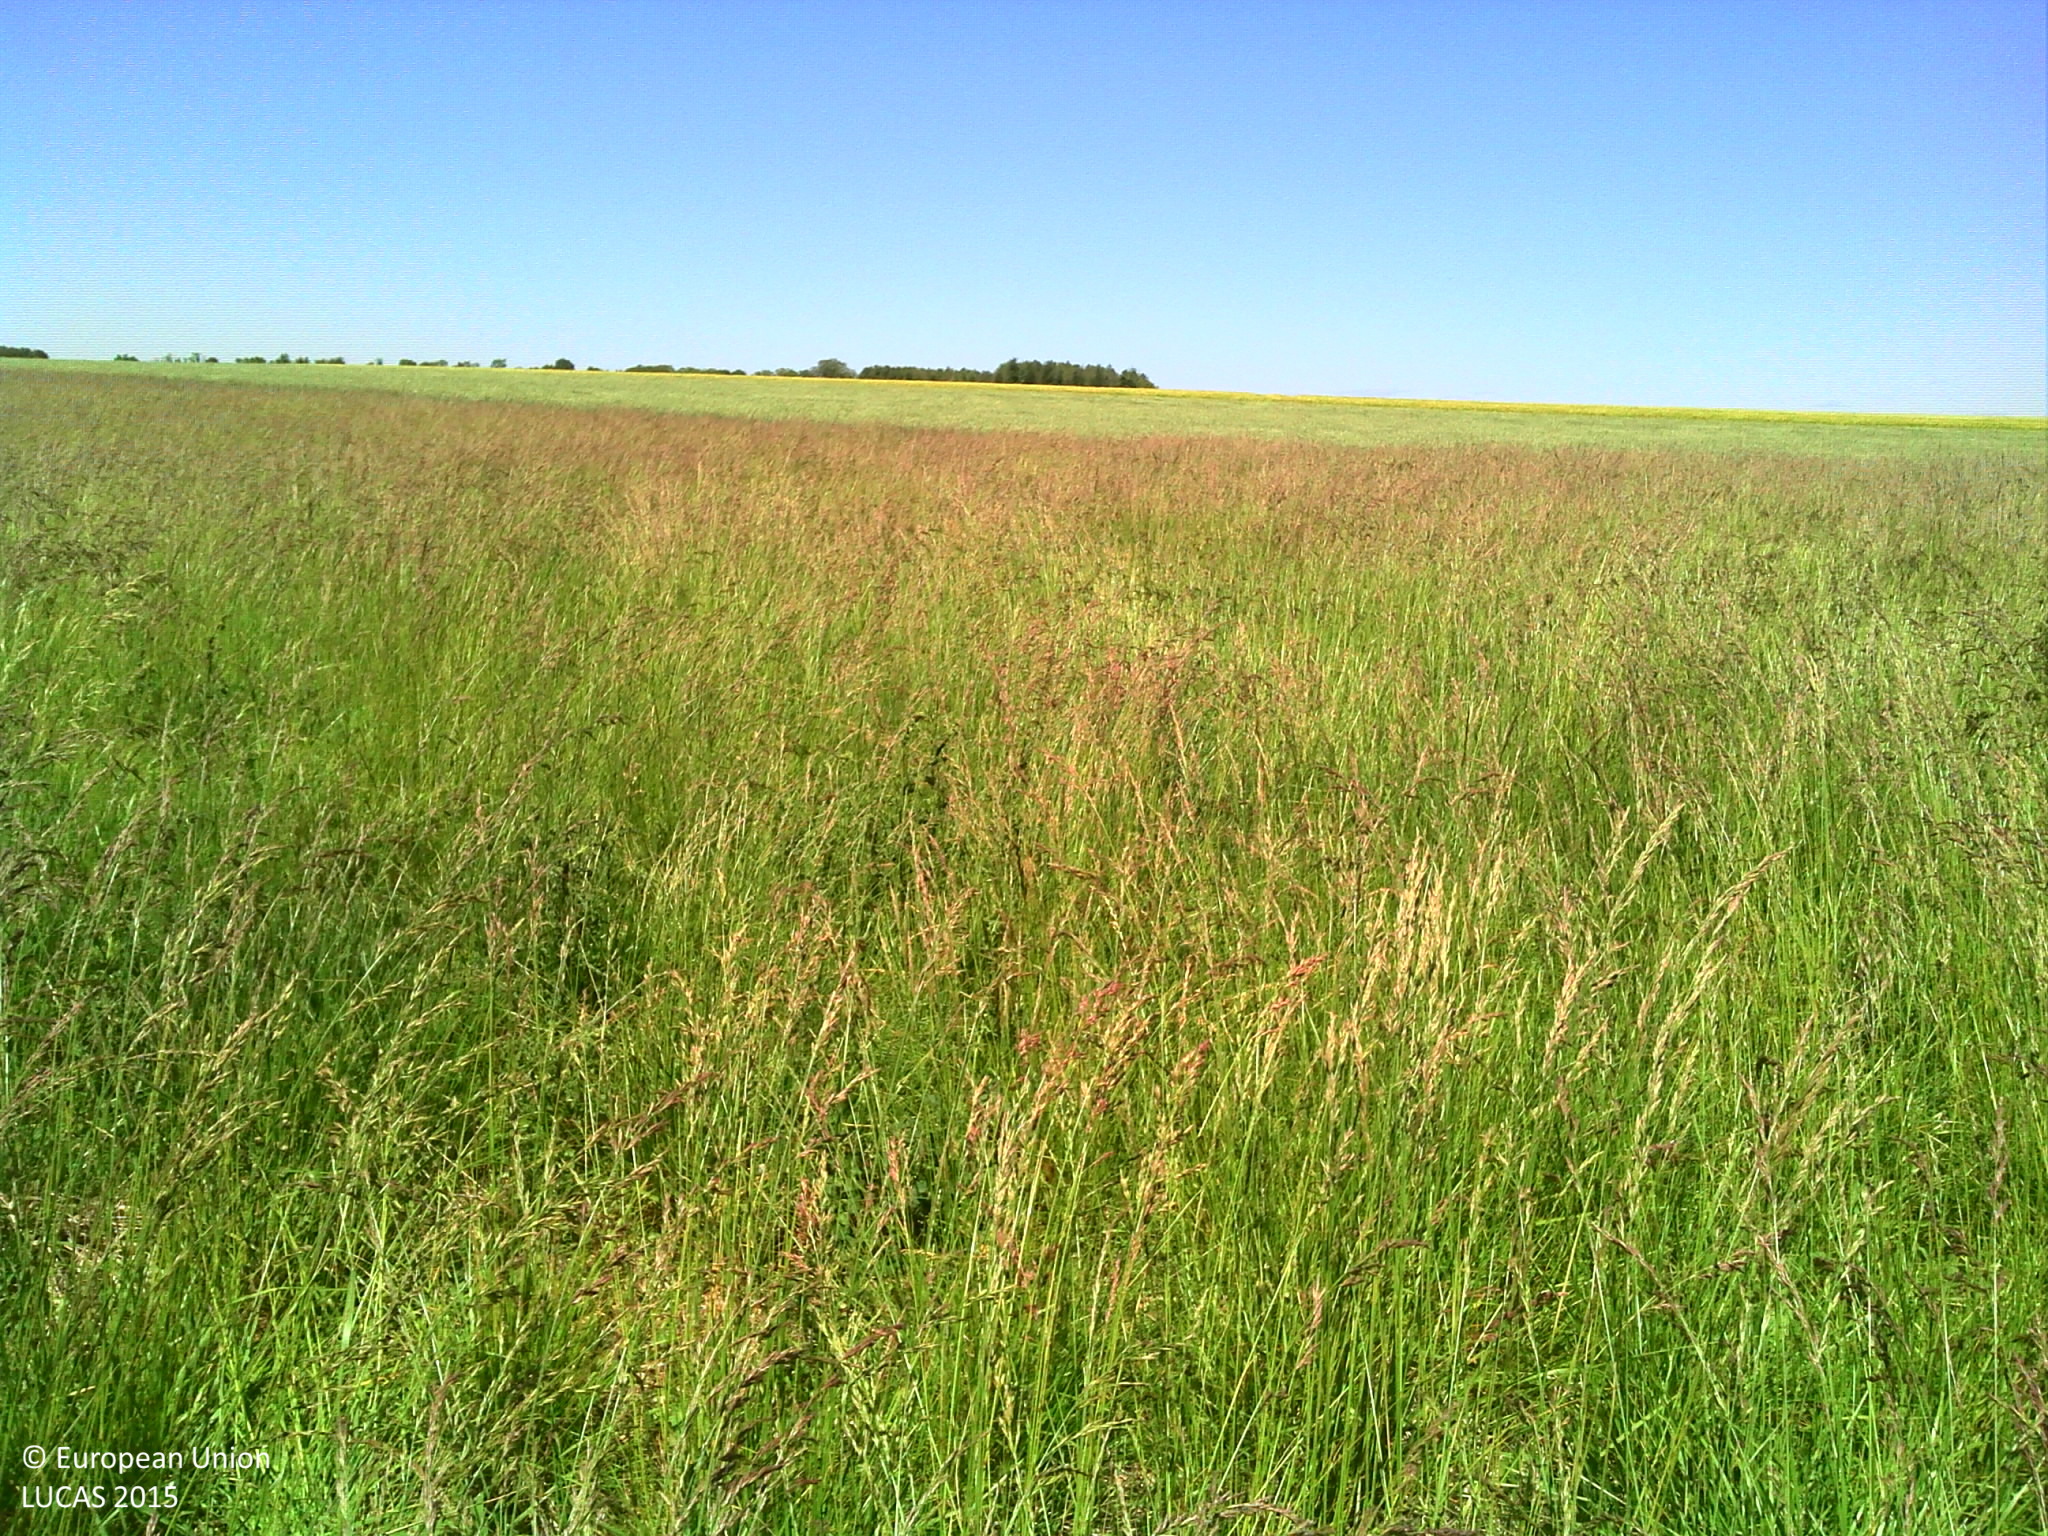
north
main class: Grassland
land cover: Grassland without tree/shrub cover
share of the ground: > 75 %
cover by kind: herbaceous plants 100 %
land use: Agriculture (excluding fallow land and kitchen gardens)
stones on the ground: 10 - 25 %
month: June
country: FR
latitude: 47.0642
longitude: 2.7659
